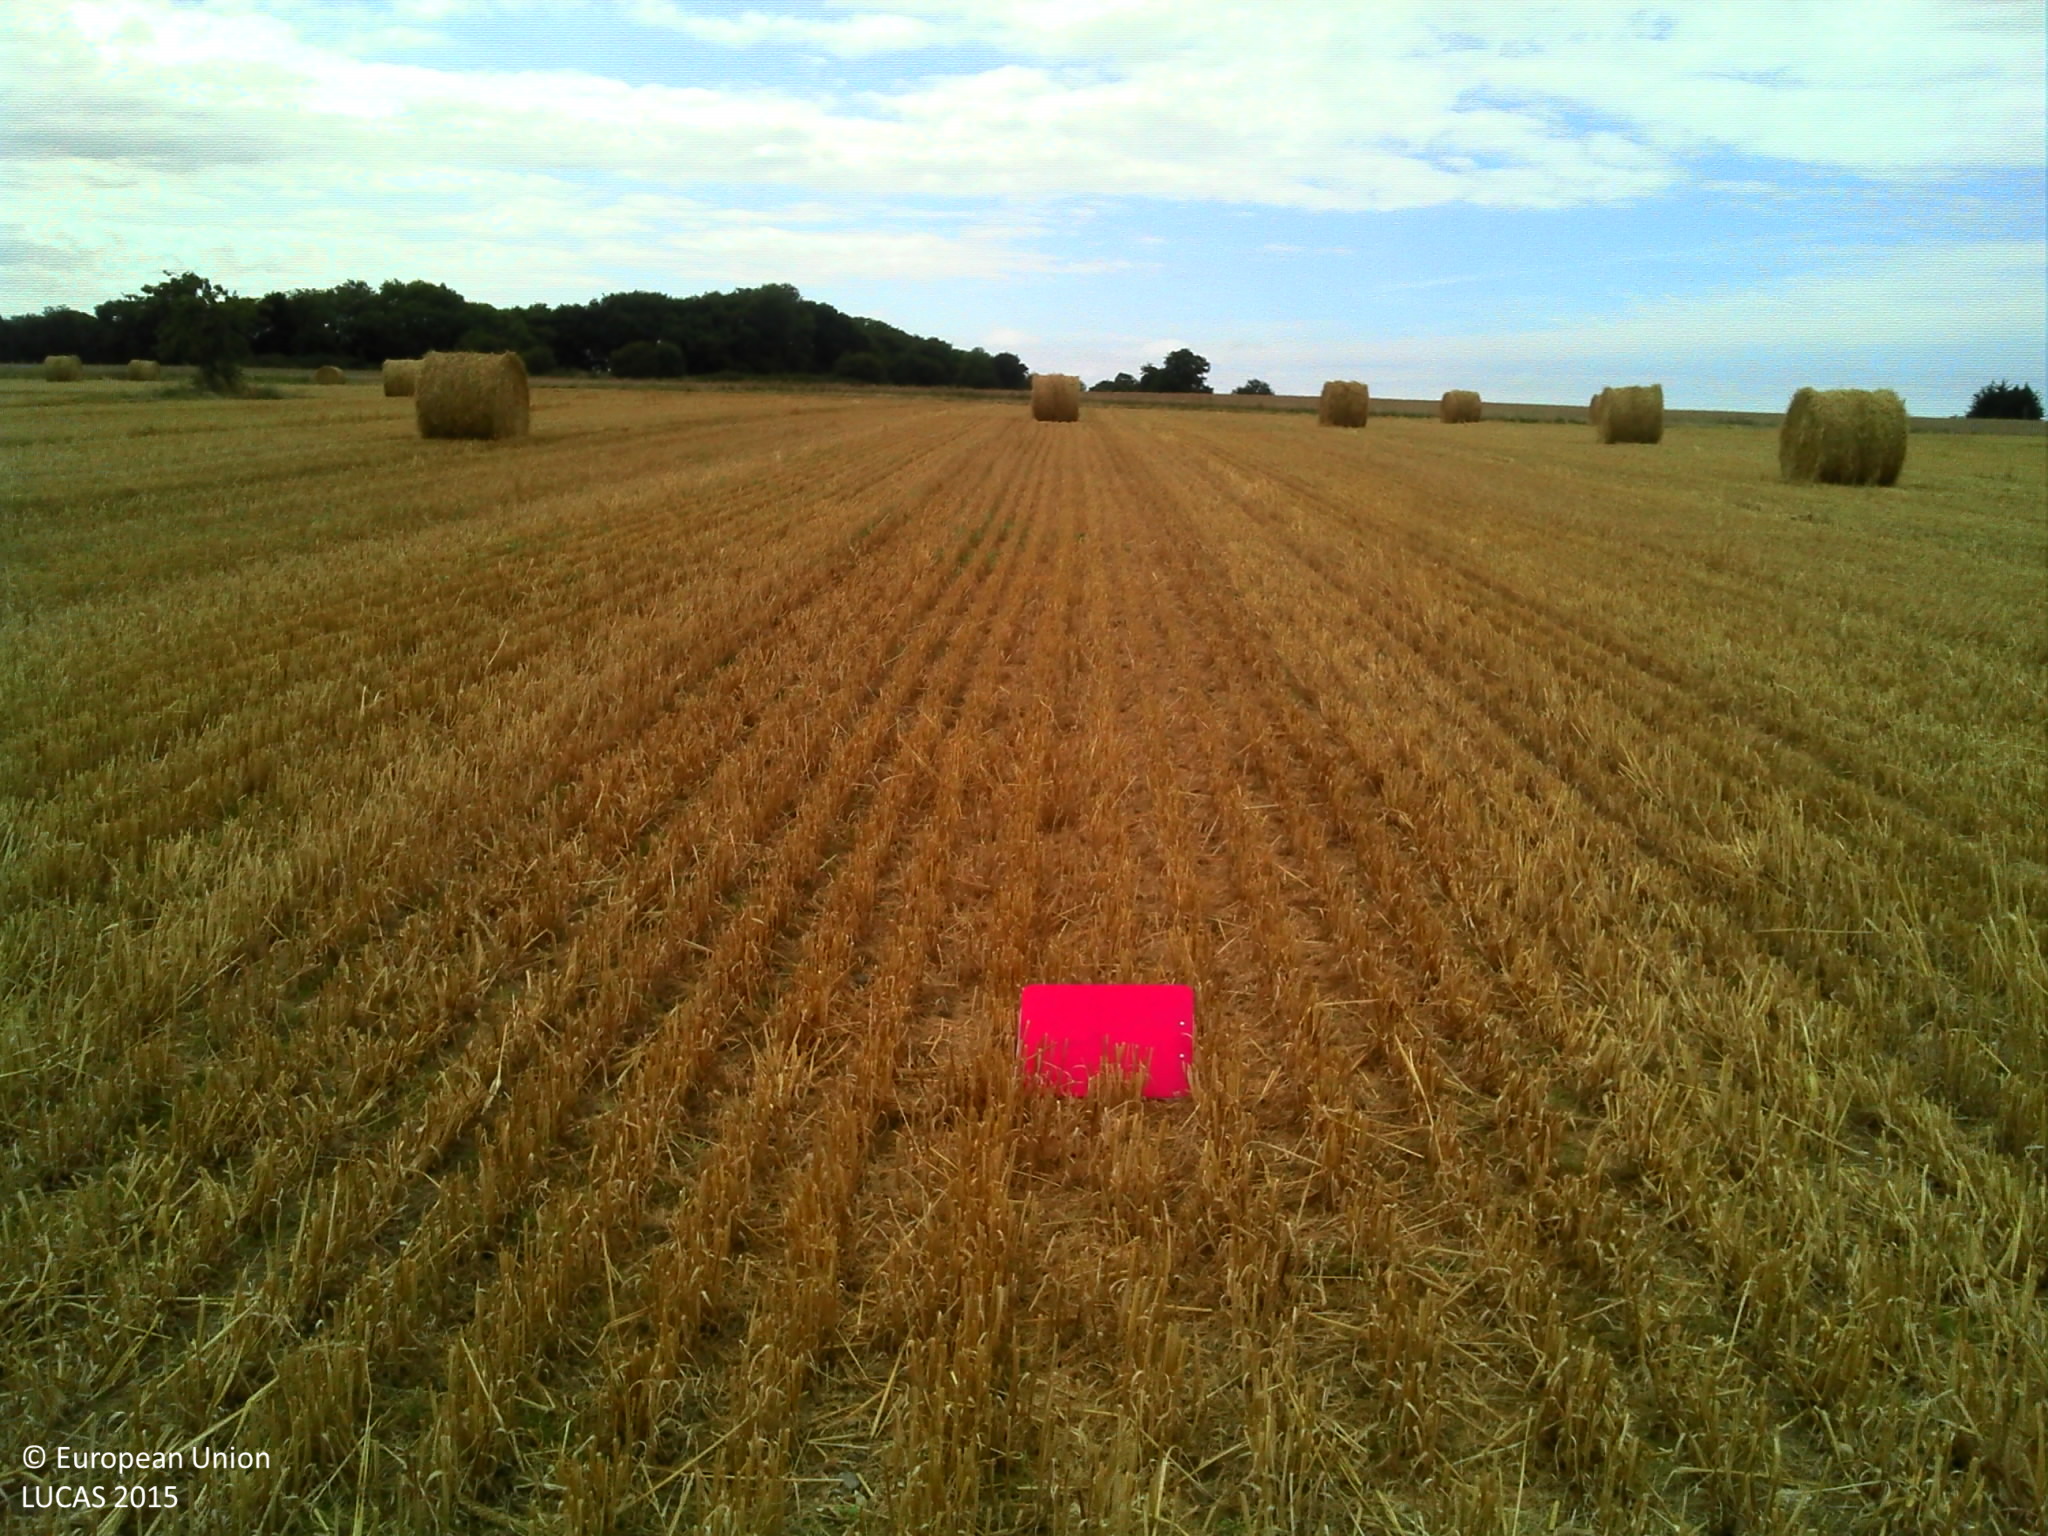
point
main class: Cropland
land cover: Barley
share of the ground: > 75 %
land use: Agriculture (excluding fallow land and kitchen gardens)
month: July
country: FR
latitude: 48.6519
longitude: -1.8760
